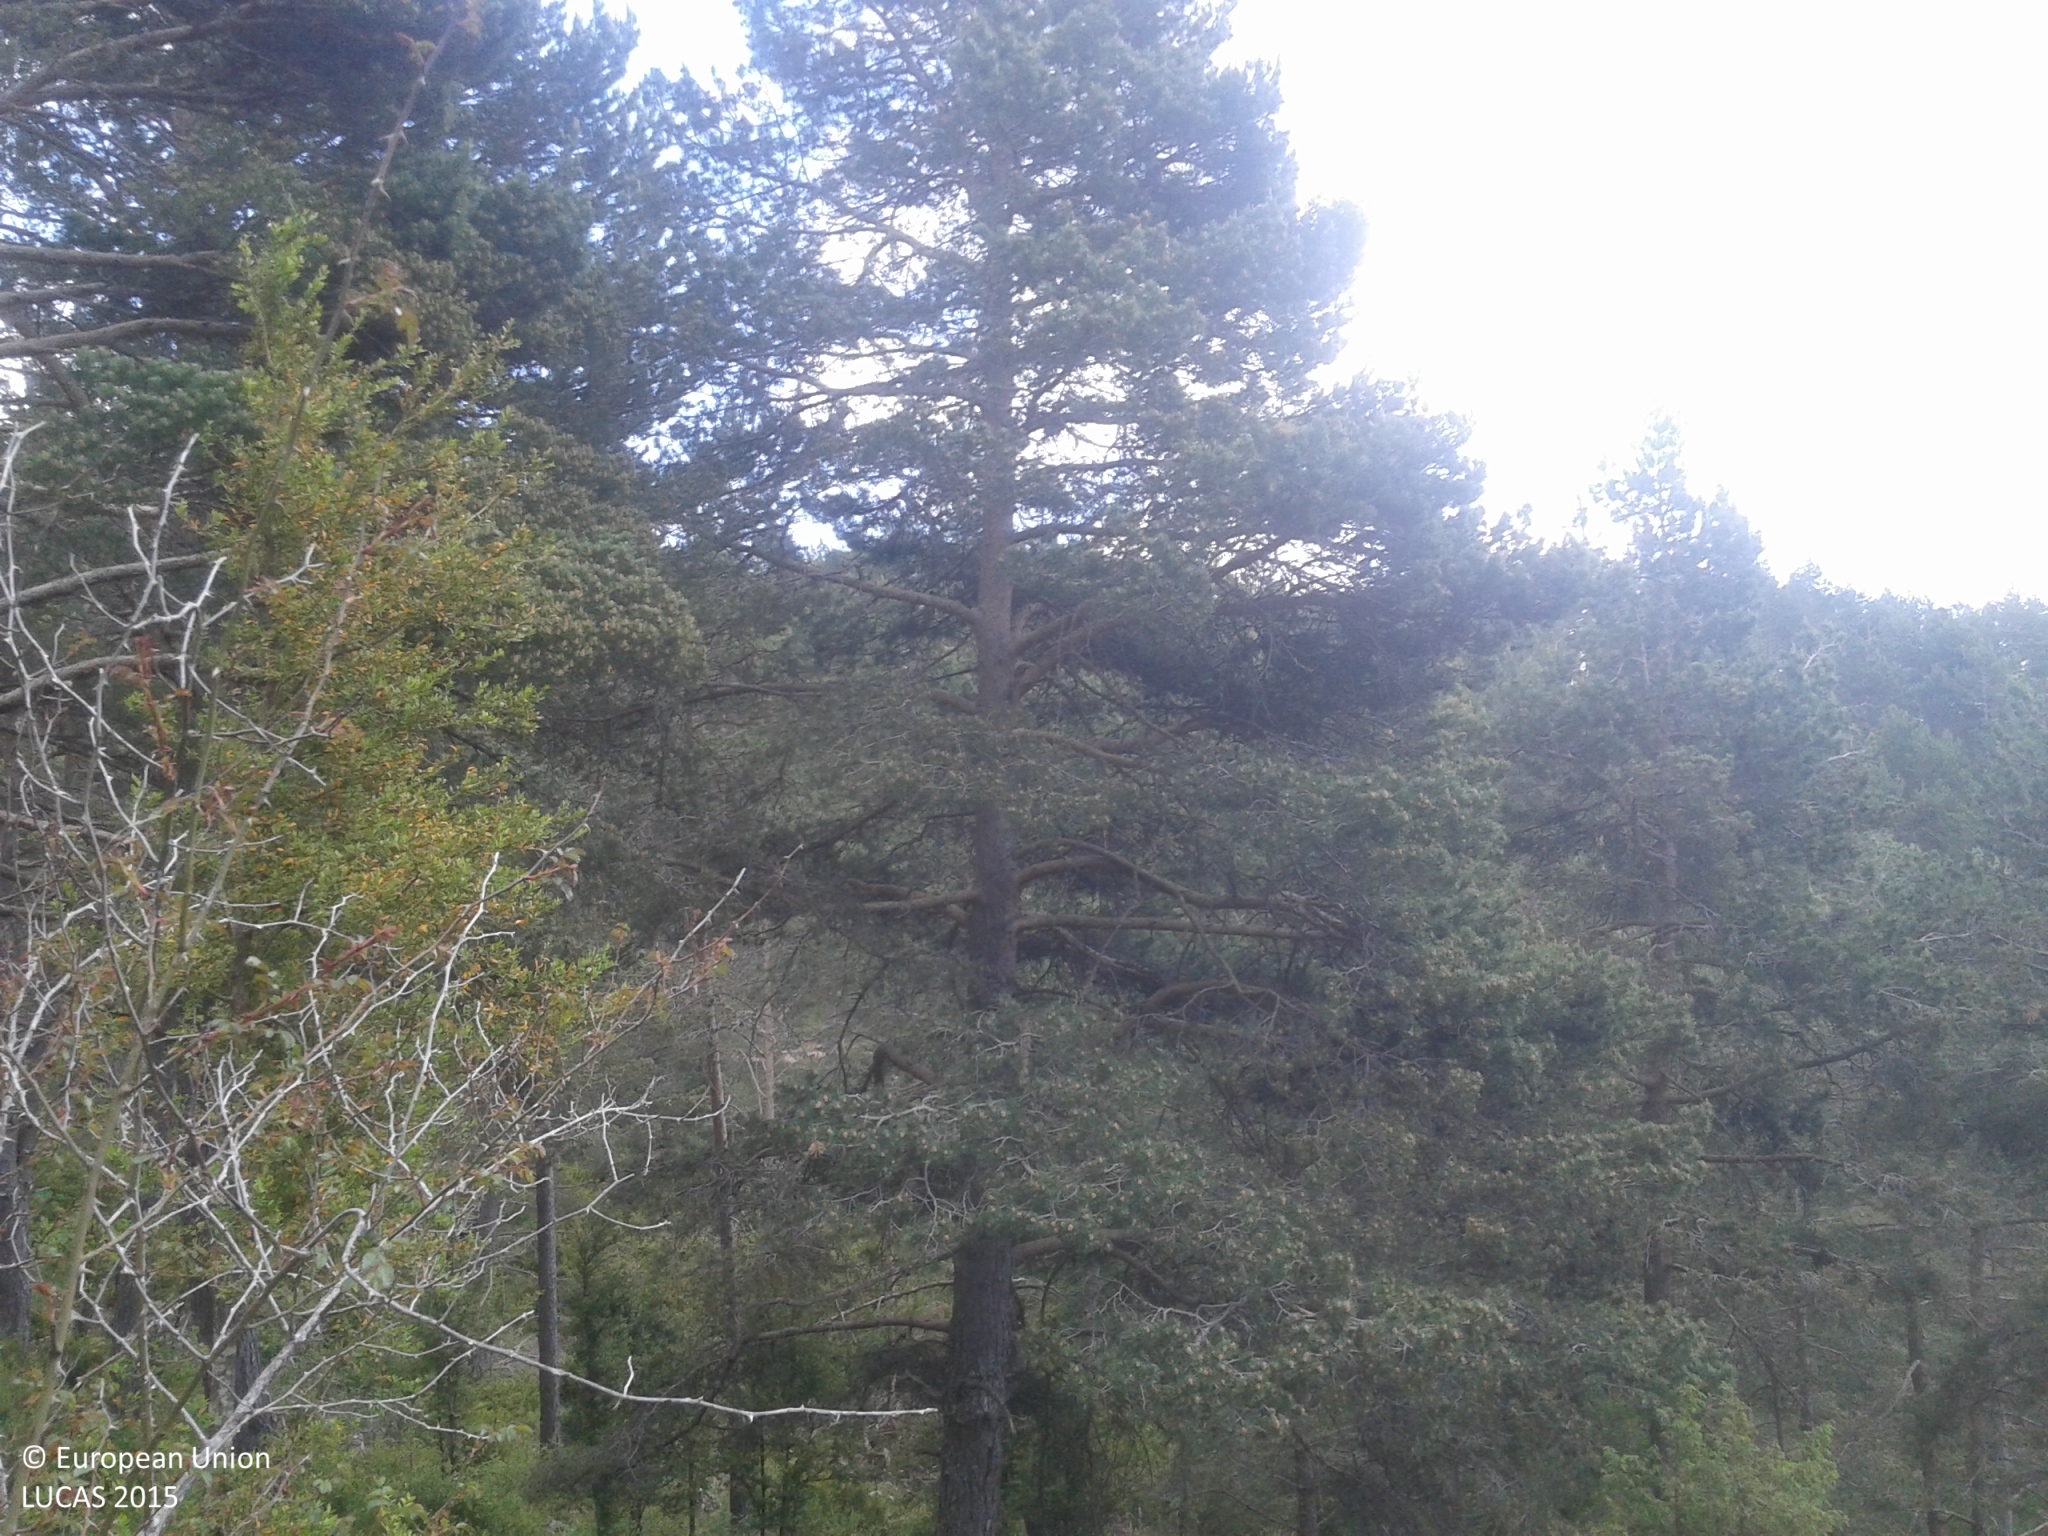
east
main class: Woodland
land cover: Pine dominated coniferous woodland
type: alpine coniferous forest
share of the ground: 50 - 75 %
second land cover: Shrubland without tree cover
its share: 50 - 75 %
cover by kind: coniferous forest trees 60 %, shrubs 35 %, herbaceous plants 5 %
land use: Forestry
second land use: Agriculture (excluding fallow land and kitchen gardens)
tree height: > 5 m
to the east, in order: Pine dominated coniferous woodland; Shrubland without tree cover; Rivers and streams; Pine dominated coniferous woodland; Fences; Tracks; Pine dominated coniferous woodland
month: May
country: ES
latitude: 42.1354
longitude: 1.5306
